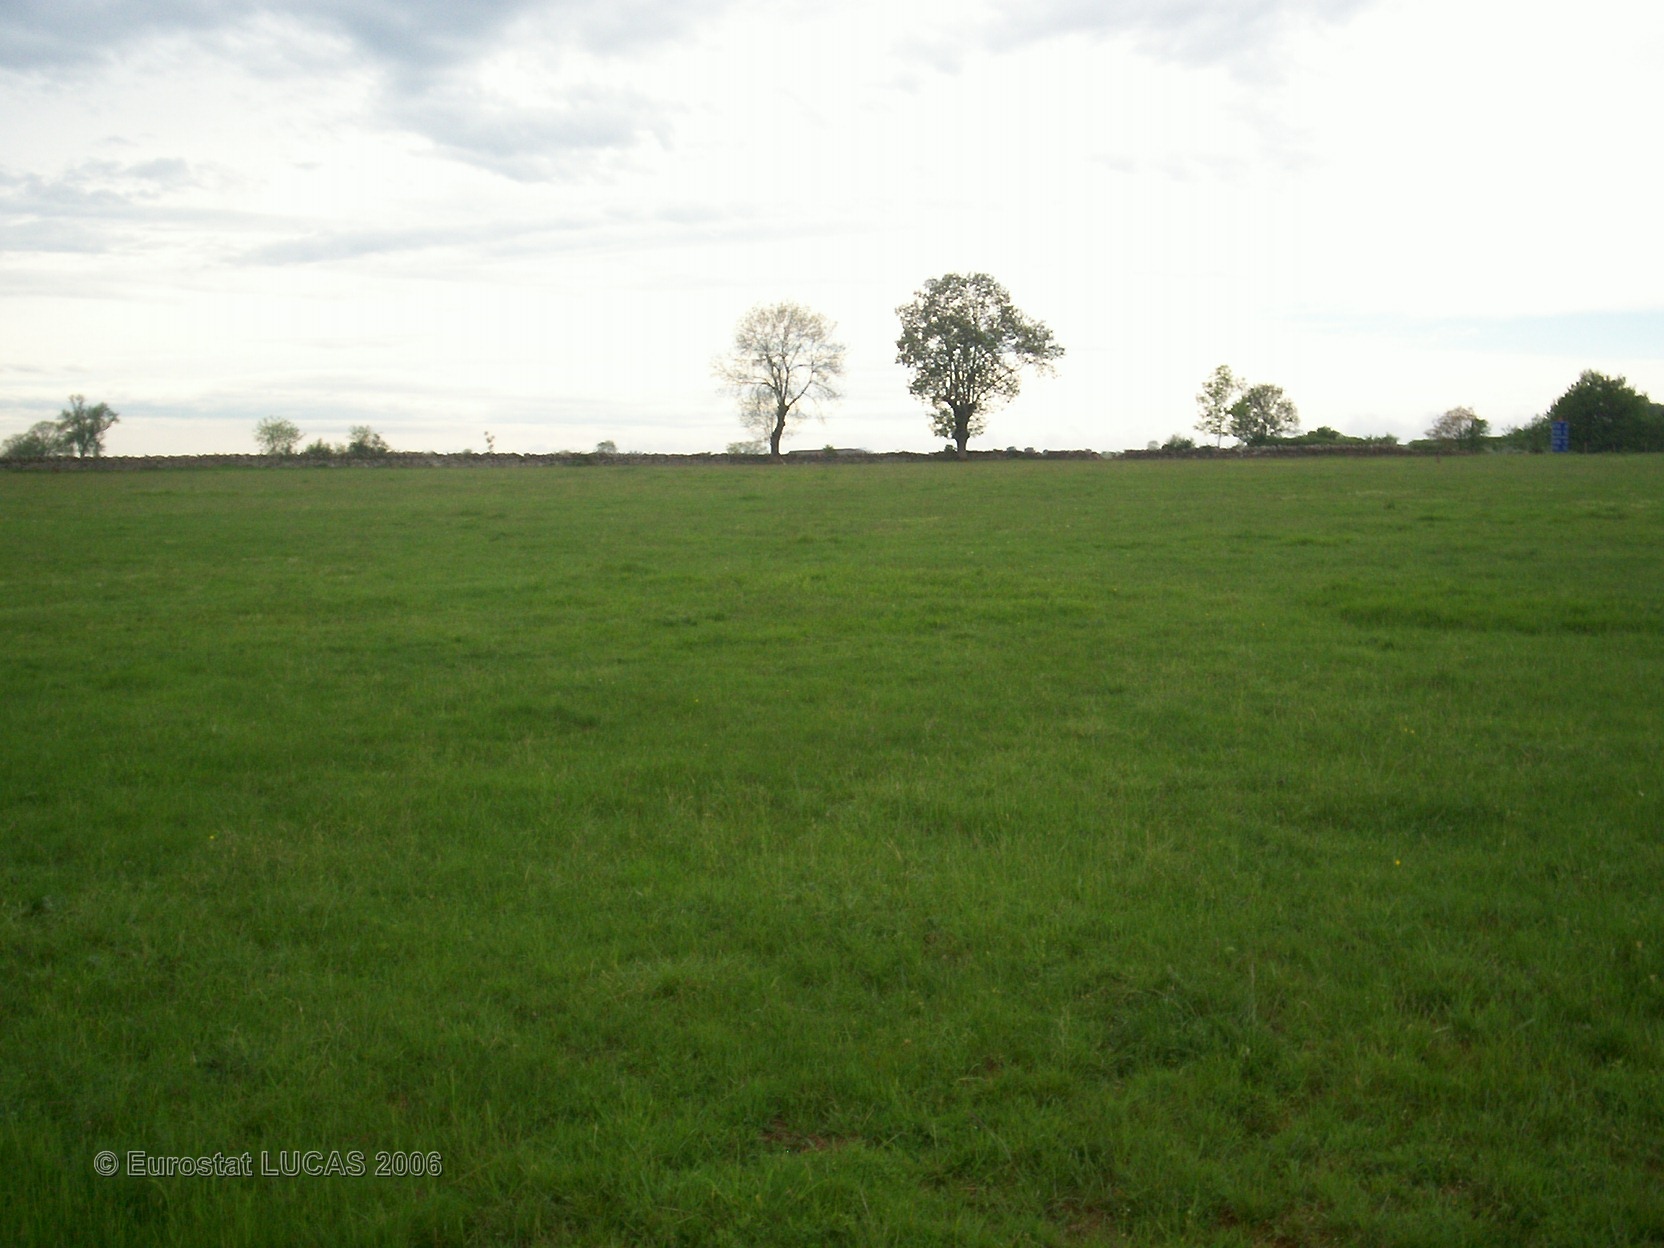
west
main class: Grassland
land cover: Grassland without tree/shrub cover
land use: Agriculture (excluding fallow land and kitchen gardens)
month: May
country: FR
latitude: 47.2805
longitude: 4.6191
